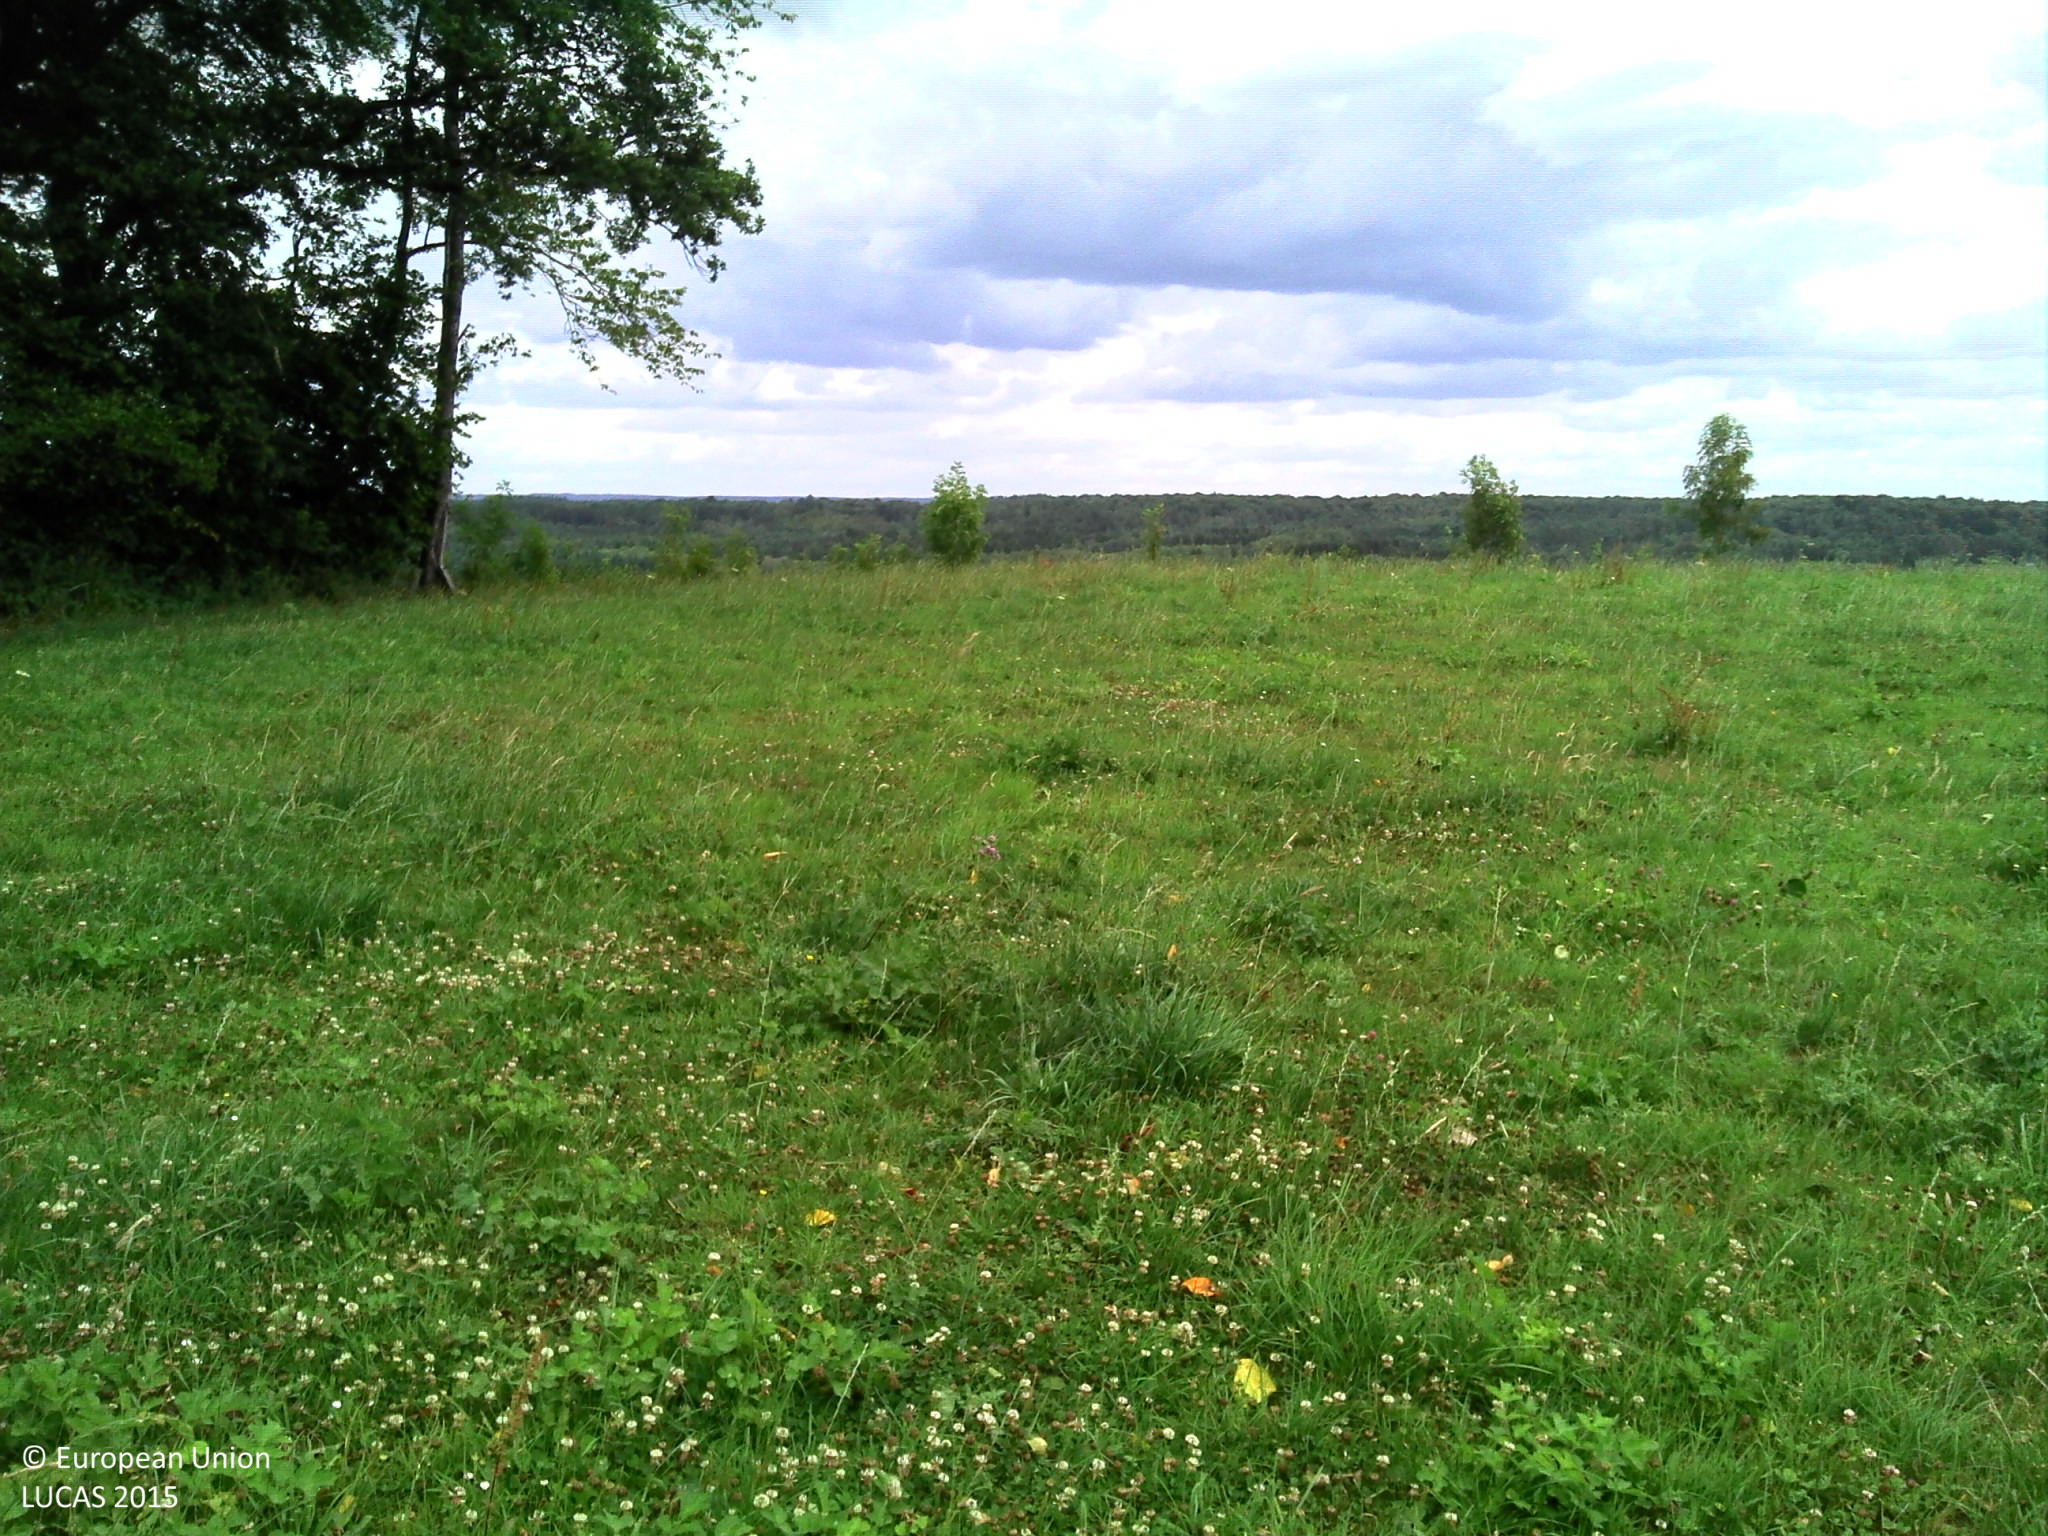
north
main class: Grassland
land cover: Grassland without tree/shrub cover
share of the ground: > 75 %
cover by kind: herbaceous plants 100 %
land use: Agriculture (excluding fallow land and kitchen gardens)
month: July
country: BE
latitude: 49.6167
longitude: 5.6942
